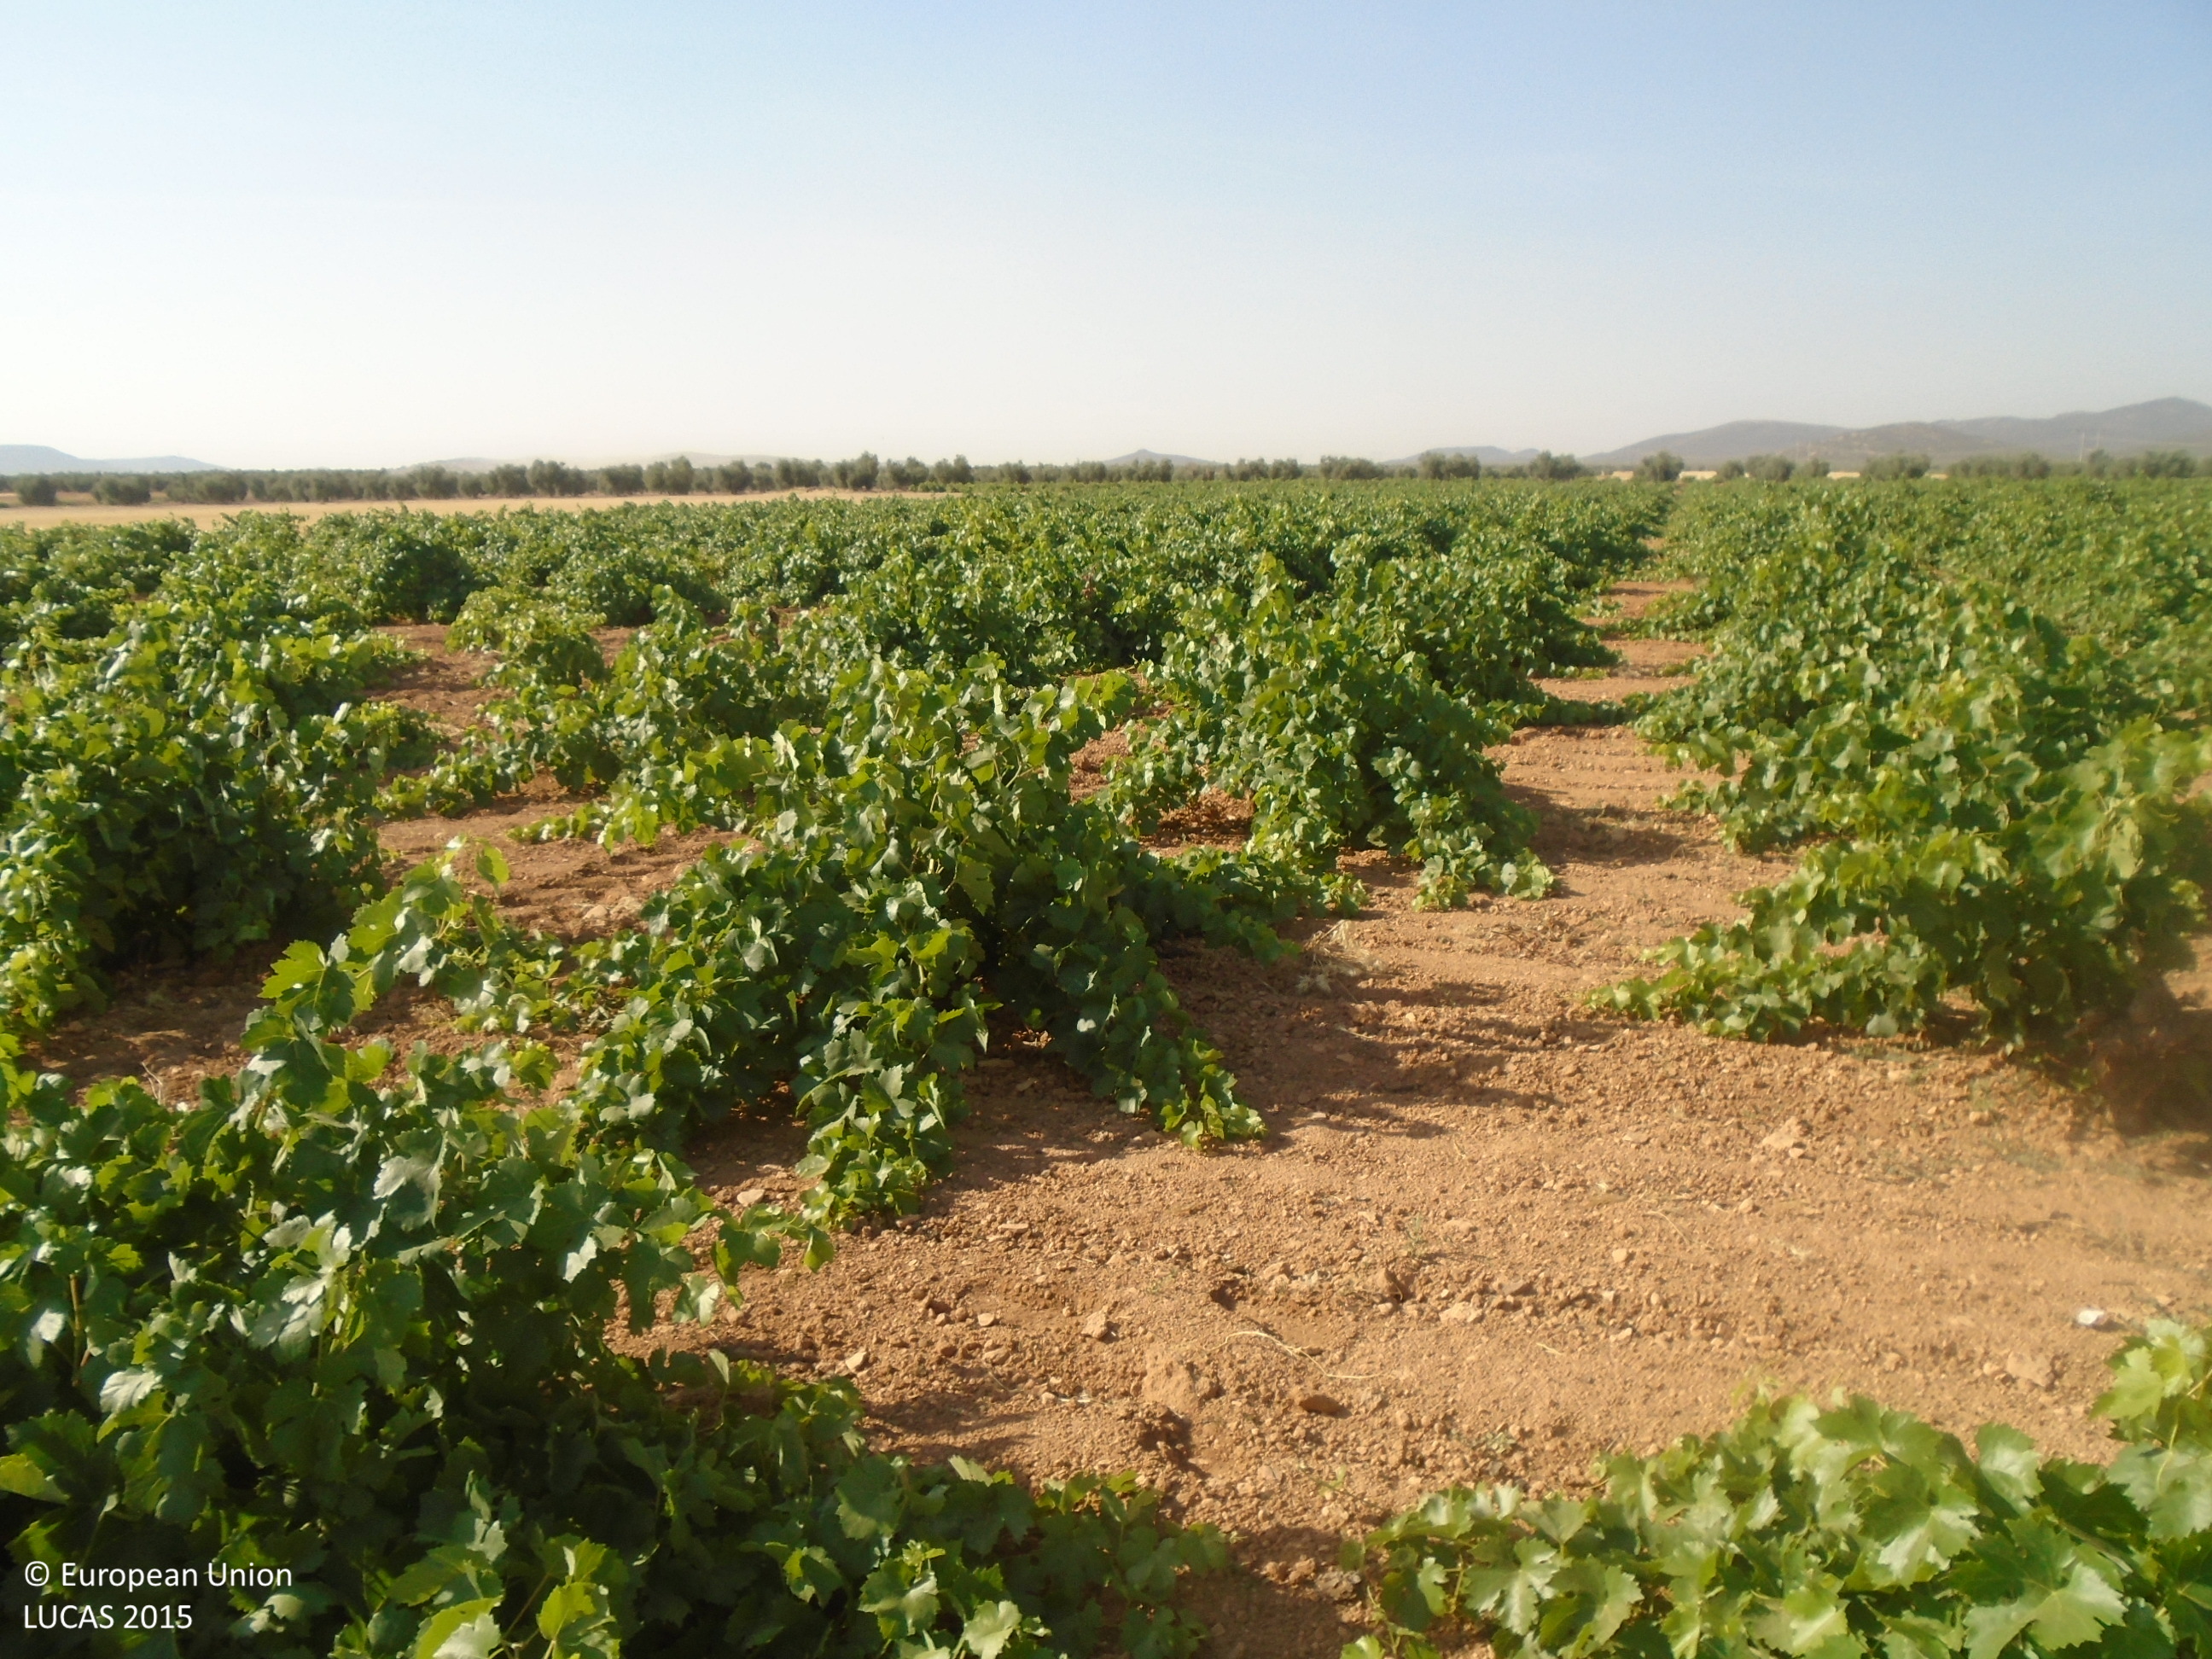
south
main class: Cropland
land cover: Vineyards
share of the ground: 10 - 25 %
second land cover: Other bare soil
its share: > 75 %
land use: Agriculture (excluding fallow land and kitchen gardens)
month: July
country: ES
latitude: 39.3991
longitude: -3.5266
